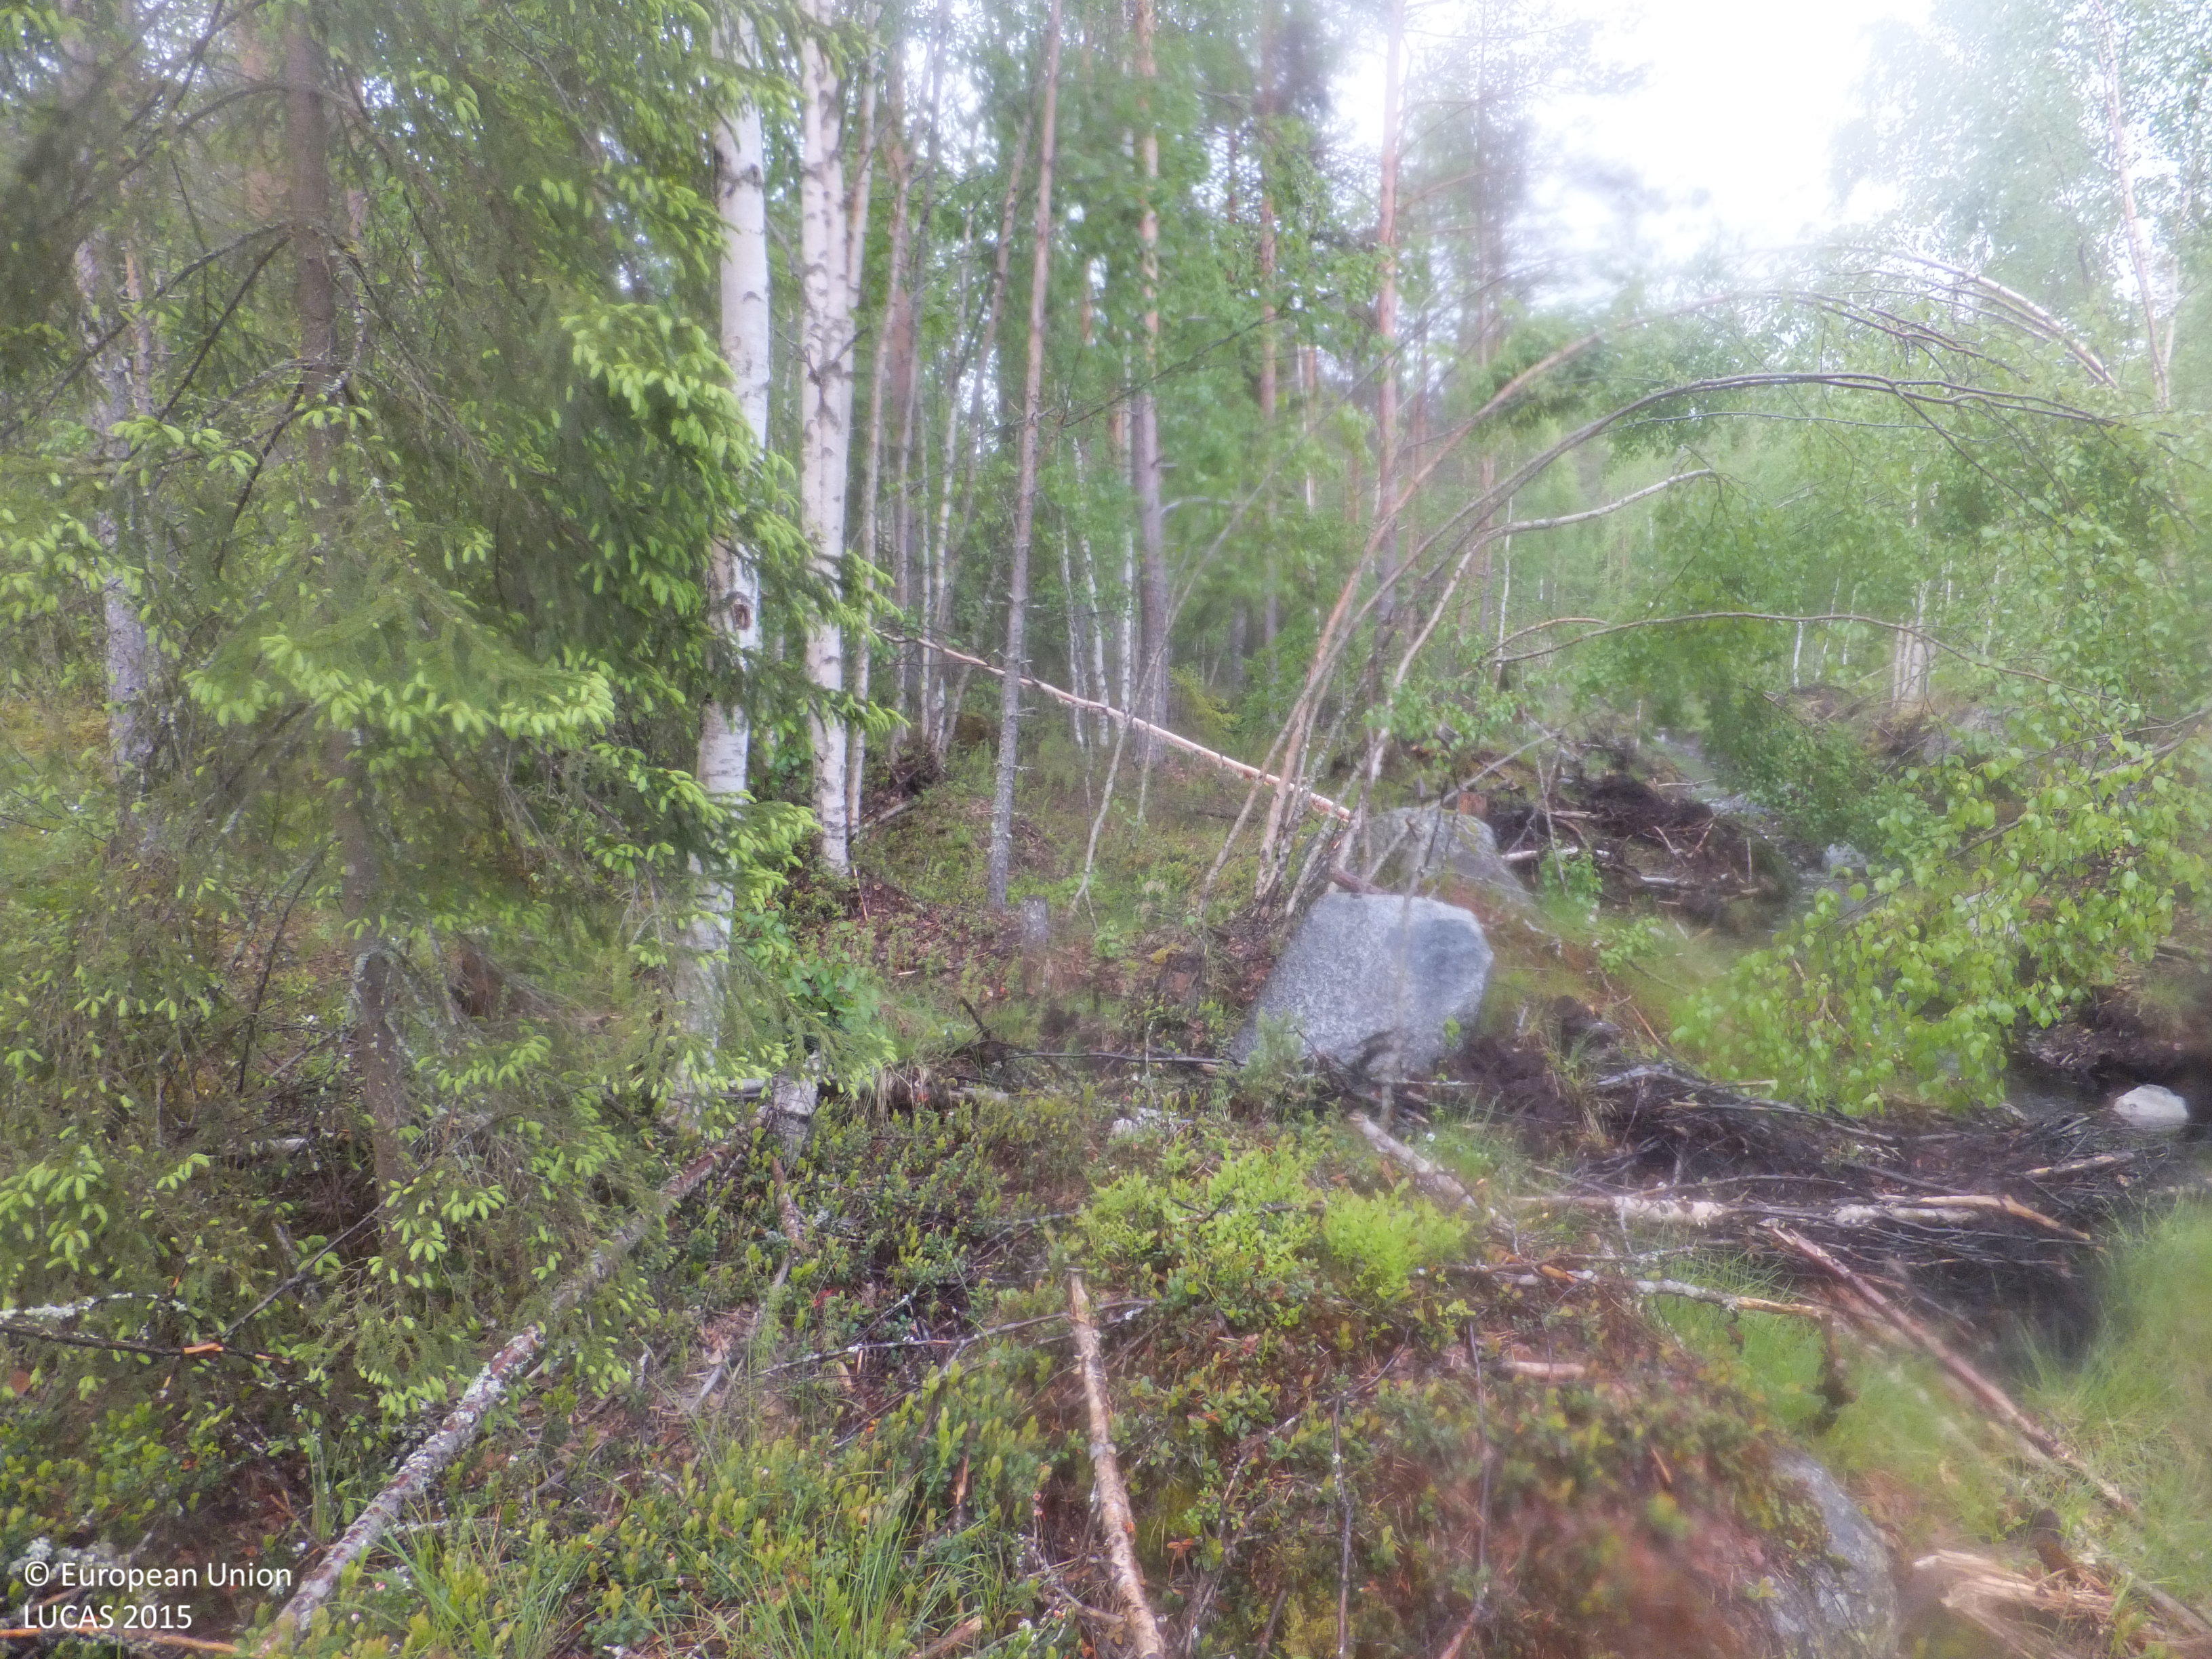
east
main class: Woodland
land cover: Pine dominated mixed woodland
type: boreal forest
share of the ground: 50 - 75 %
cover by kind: coniferous forest trees 30 %, broadleaved forest trees 30 %, herbaceous plants 15 %, shrubs 10 %, lichens and mosses 10 %, unconsolidated bare surface 5 %
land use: Forestry
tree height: > 5 m
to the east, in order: Pine dominated mixed woodland; Ditches and canals; Pine dominated mixed woodland; Pine dominated coniferous woodland; Ditches and canals; Pine dominated mixed woodland; Ditches and canals; Pine dominated mixed woodland; Ditches and canals; Pine dominated mixed woodland; Pine dominated coniferous woodland; Ditches and canals; Other mixed woodland
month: June
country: FI
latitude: 63.7273
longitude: 24.8873
